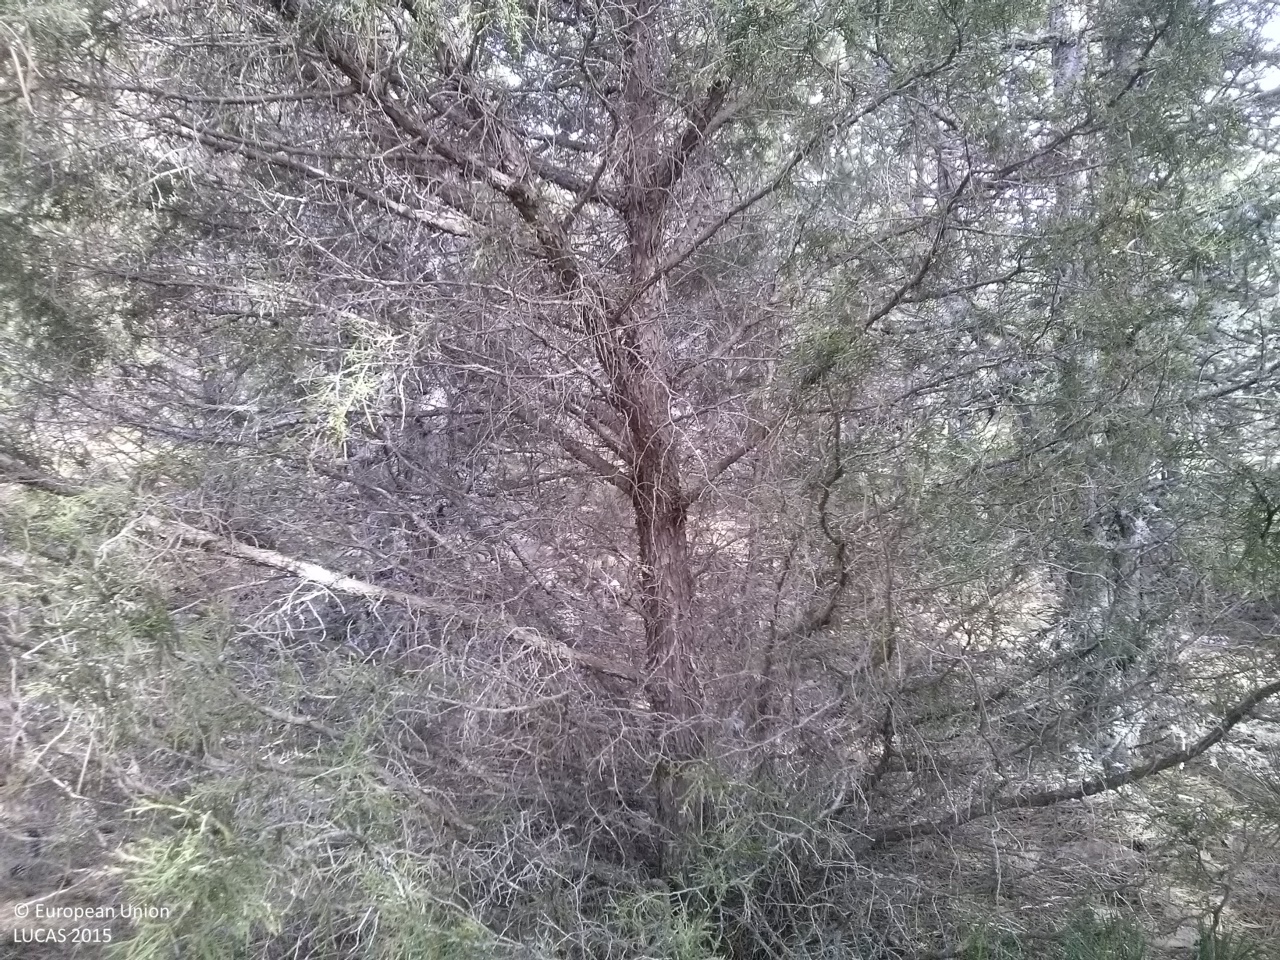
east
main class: Woodland
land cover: Pine dominated coniferous woodland
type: coniferous forest of the mediterranean region
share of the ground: 50 - 75 %
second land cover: Grassland without tree/shrub cover
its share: 10 - 25 %
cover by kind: coniferous forest trees 70 %, herbaceous plants 25 %, shrubs 5 %
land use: Forestry
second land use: Agriculture (excluding fallow land and kitchen gardens)
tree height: > 5 m
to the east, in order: Pine dominated coniferous woodland; Grassland without tree/shrub cover; Pine dominated coniferous woodland
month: April
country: ES
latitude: 40.0918
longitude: -1.8717
